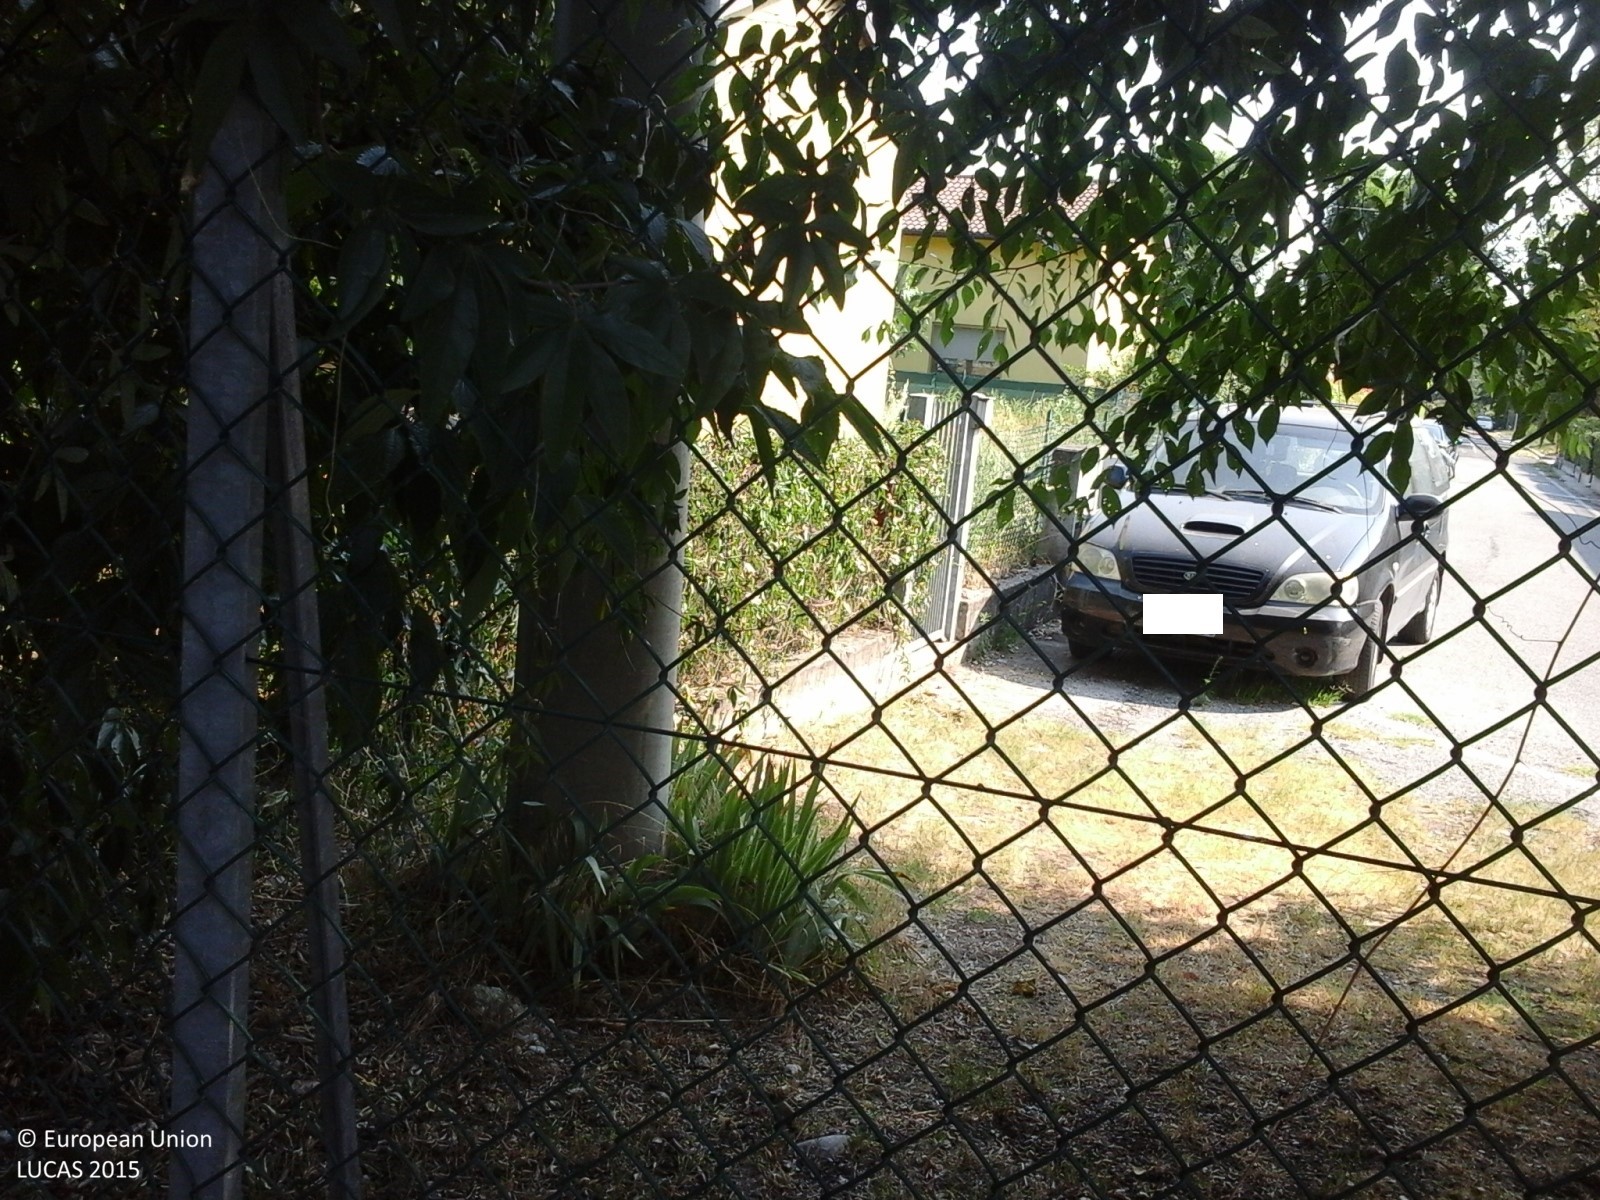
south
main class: Grassland
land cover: Grassland without tree/shrub cover
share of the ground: > 75 %
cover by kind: herbaceous plants 100 %
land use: Residential
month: July
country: IT
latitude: 45.3568
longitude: 10.8538
